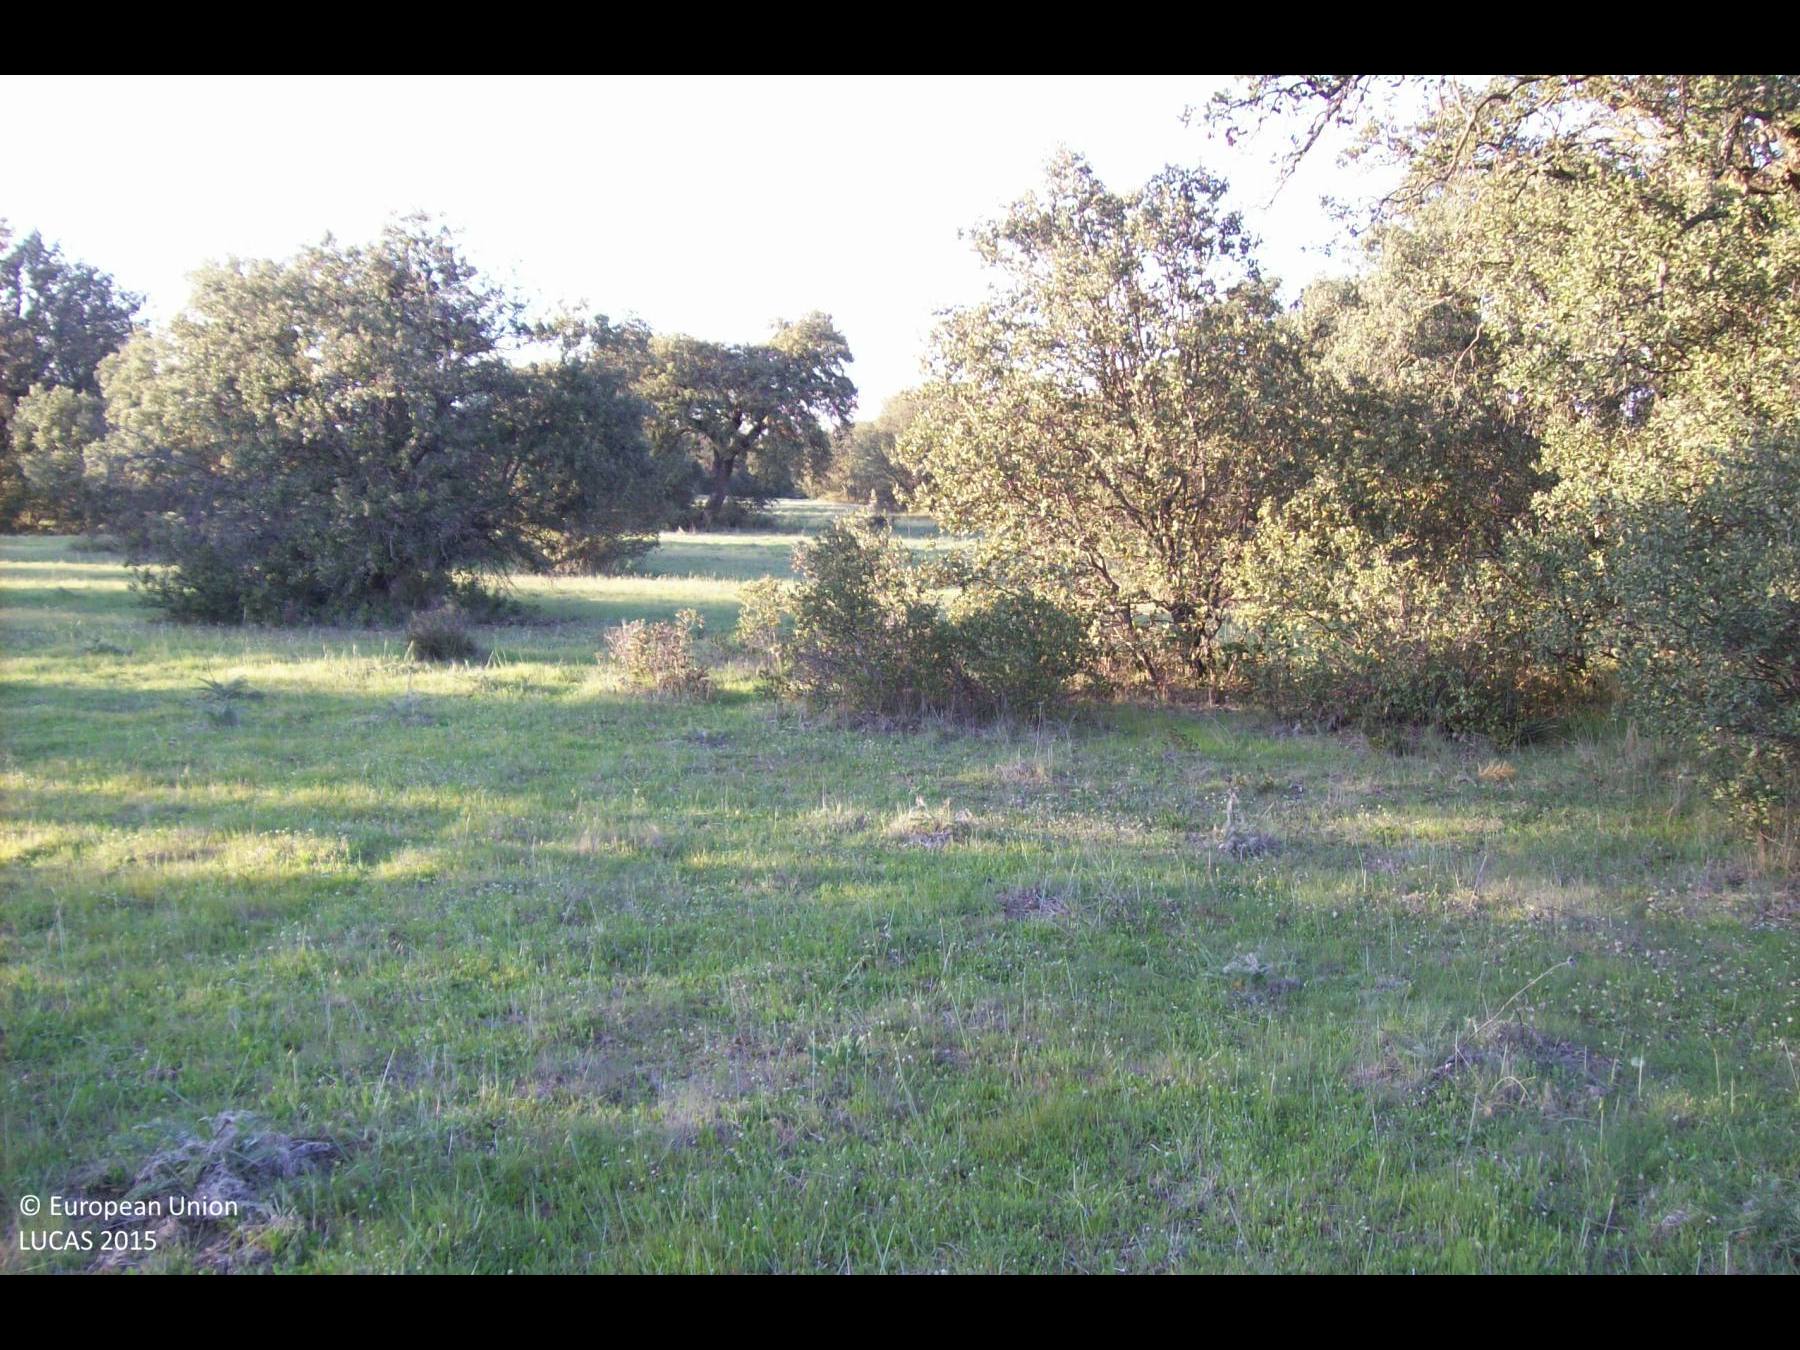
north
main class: Woodland
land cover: Broadleaved woodland
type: broadleaved evergreen forest
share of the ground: 25 - 50 %
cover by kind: herbaceous plants 55 %, broadleaved forest trees 45 %
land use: Forestry
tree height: < 5 m
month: April
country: ES
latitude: 40.4218
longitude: -3.9366
